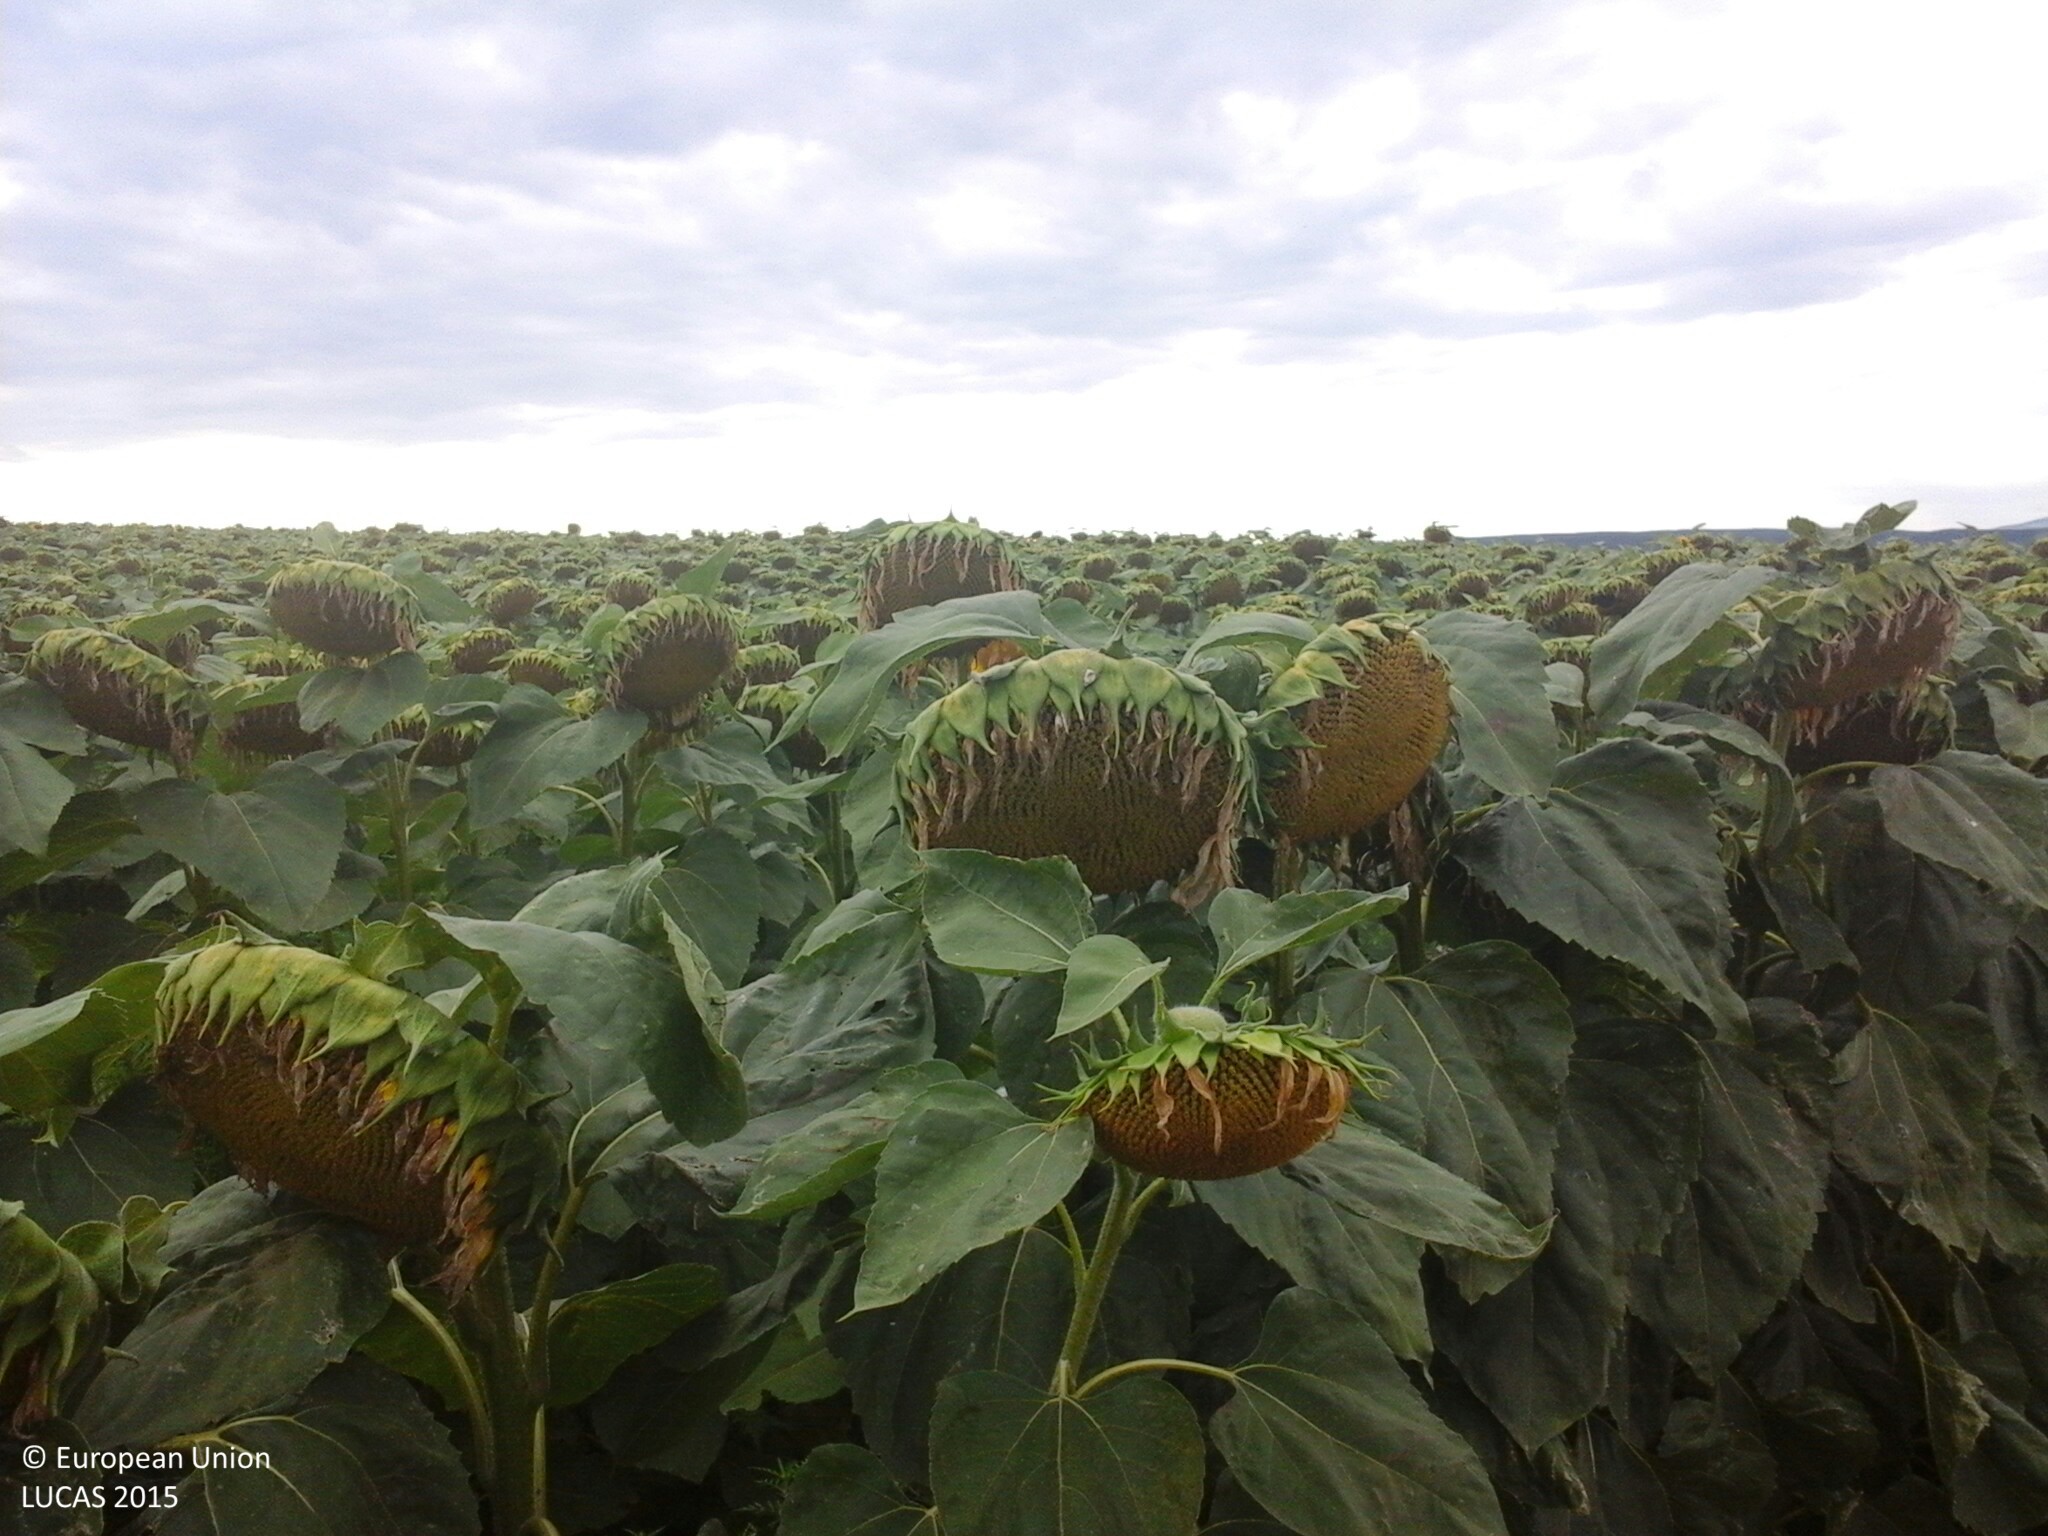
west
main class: Cropland
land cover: Sunflower
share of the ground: > 75 %
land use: Agriculture (excluding fallow land and kitchen gardens)
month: July
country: HU
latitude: 47.0585
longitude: 18.0802
